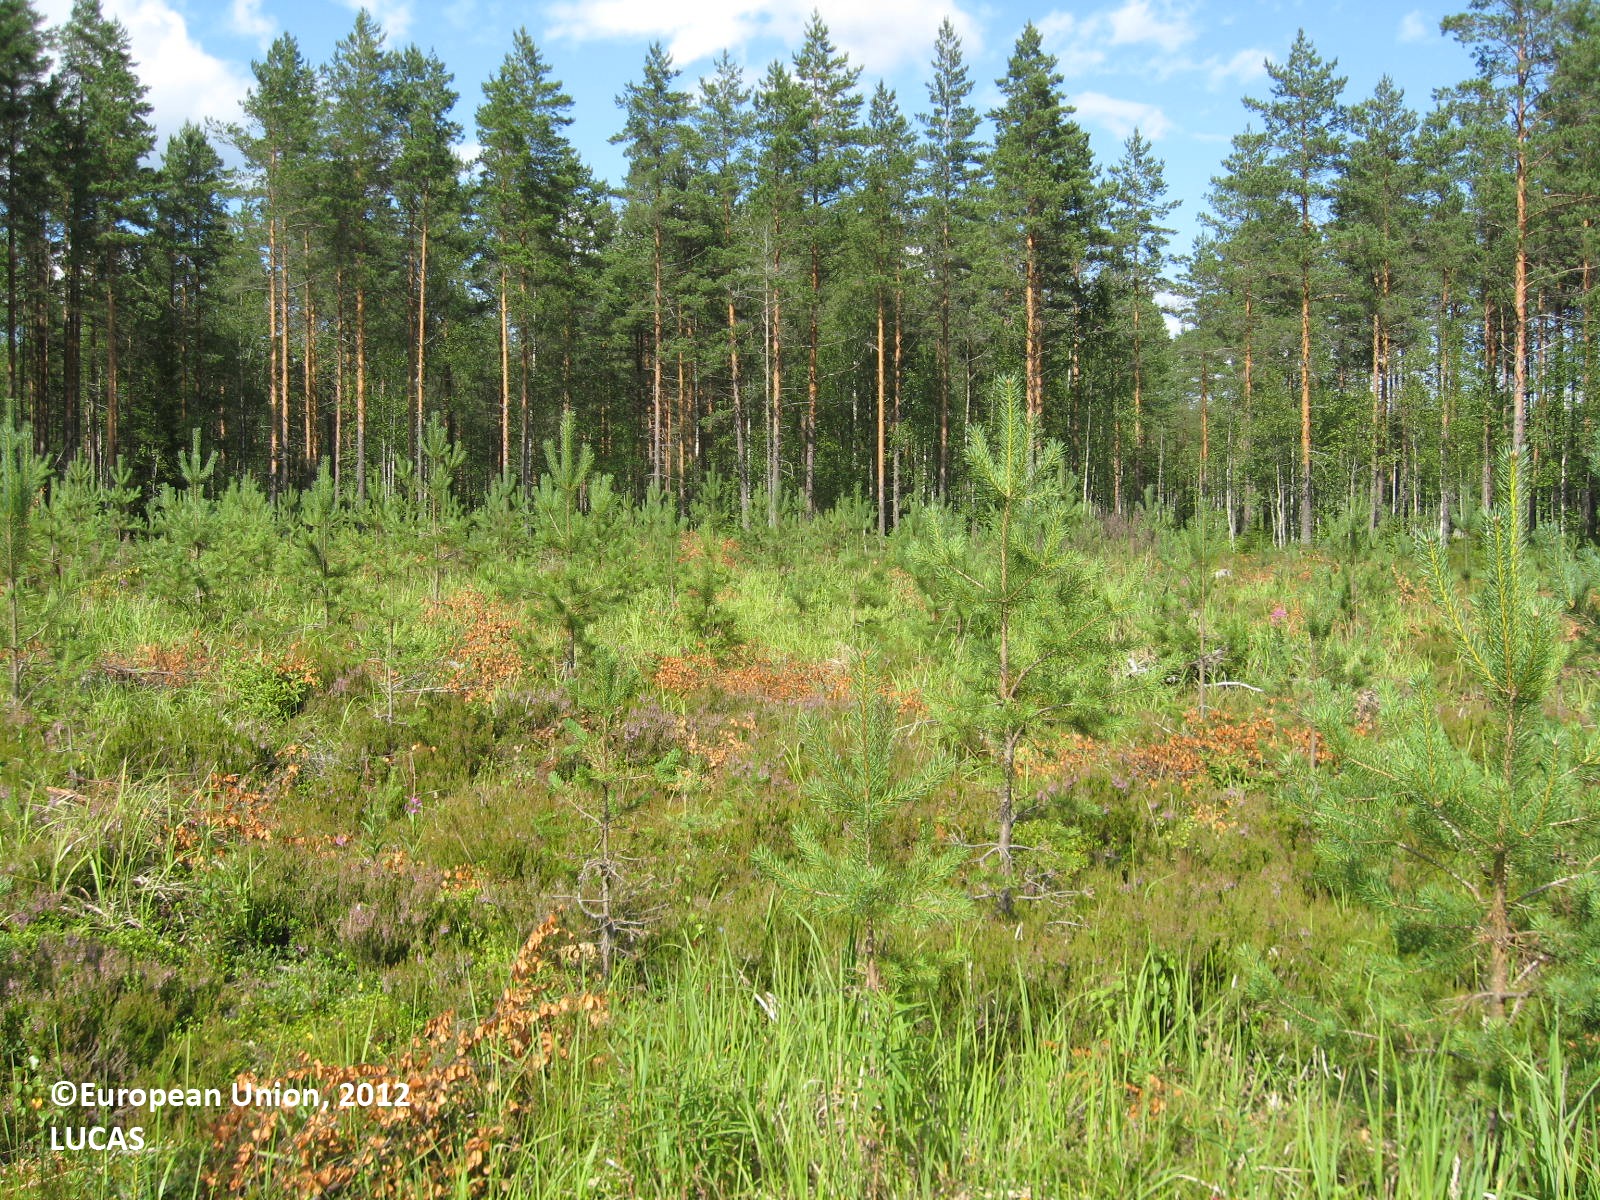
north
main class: Woodland
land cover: Pine dominated coniferous woodland
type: boreal forest
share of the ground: 25 - 50 %
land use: Forestry
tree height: < 5 m
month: July
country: FI
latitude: 62.0002
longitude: 22.6834
